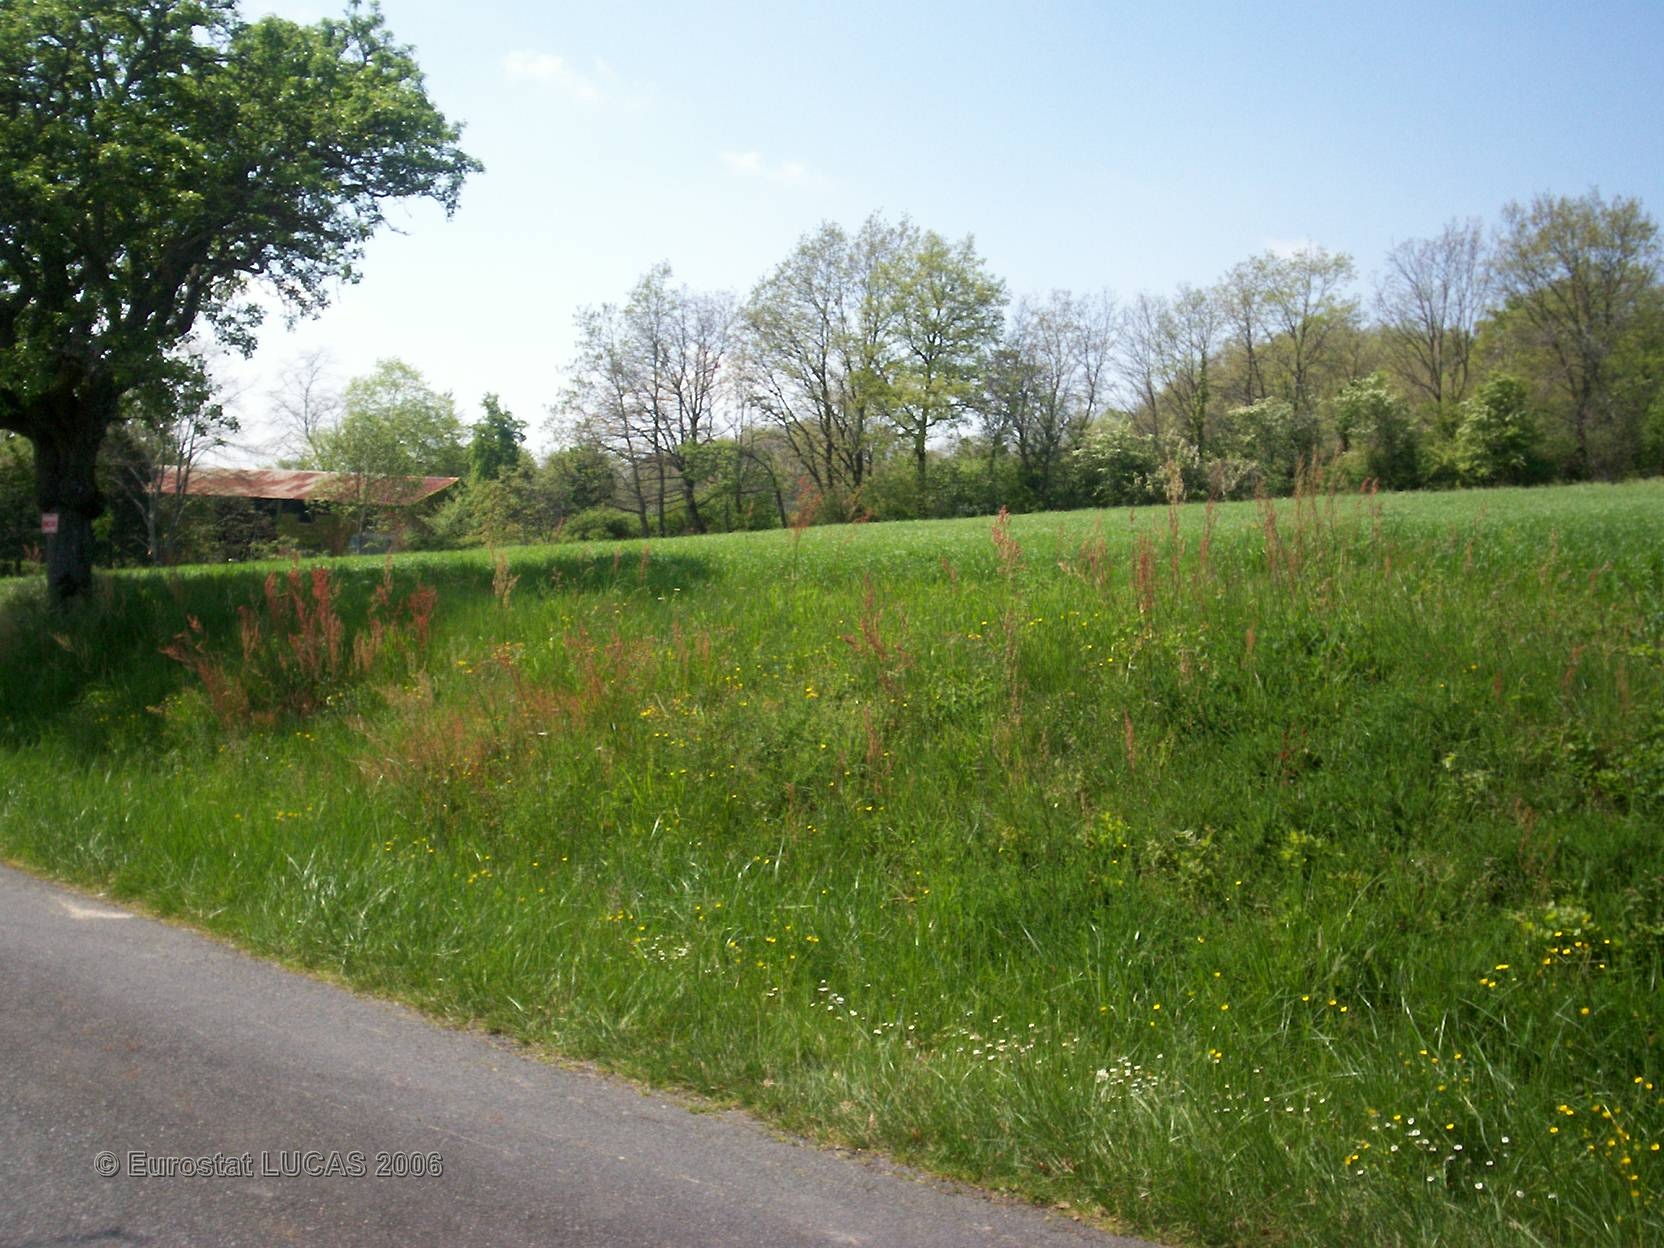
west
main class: Woodland
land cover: Broadleaved forest
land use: Forestry
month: April
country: FR
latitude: 43.6812
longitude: 2.0284
